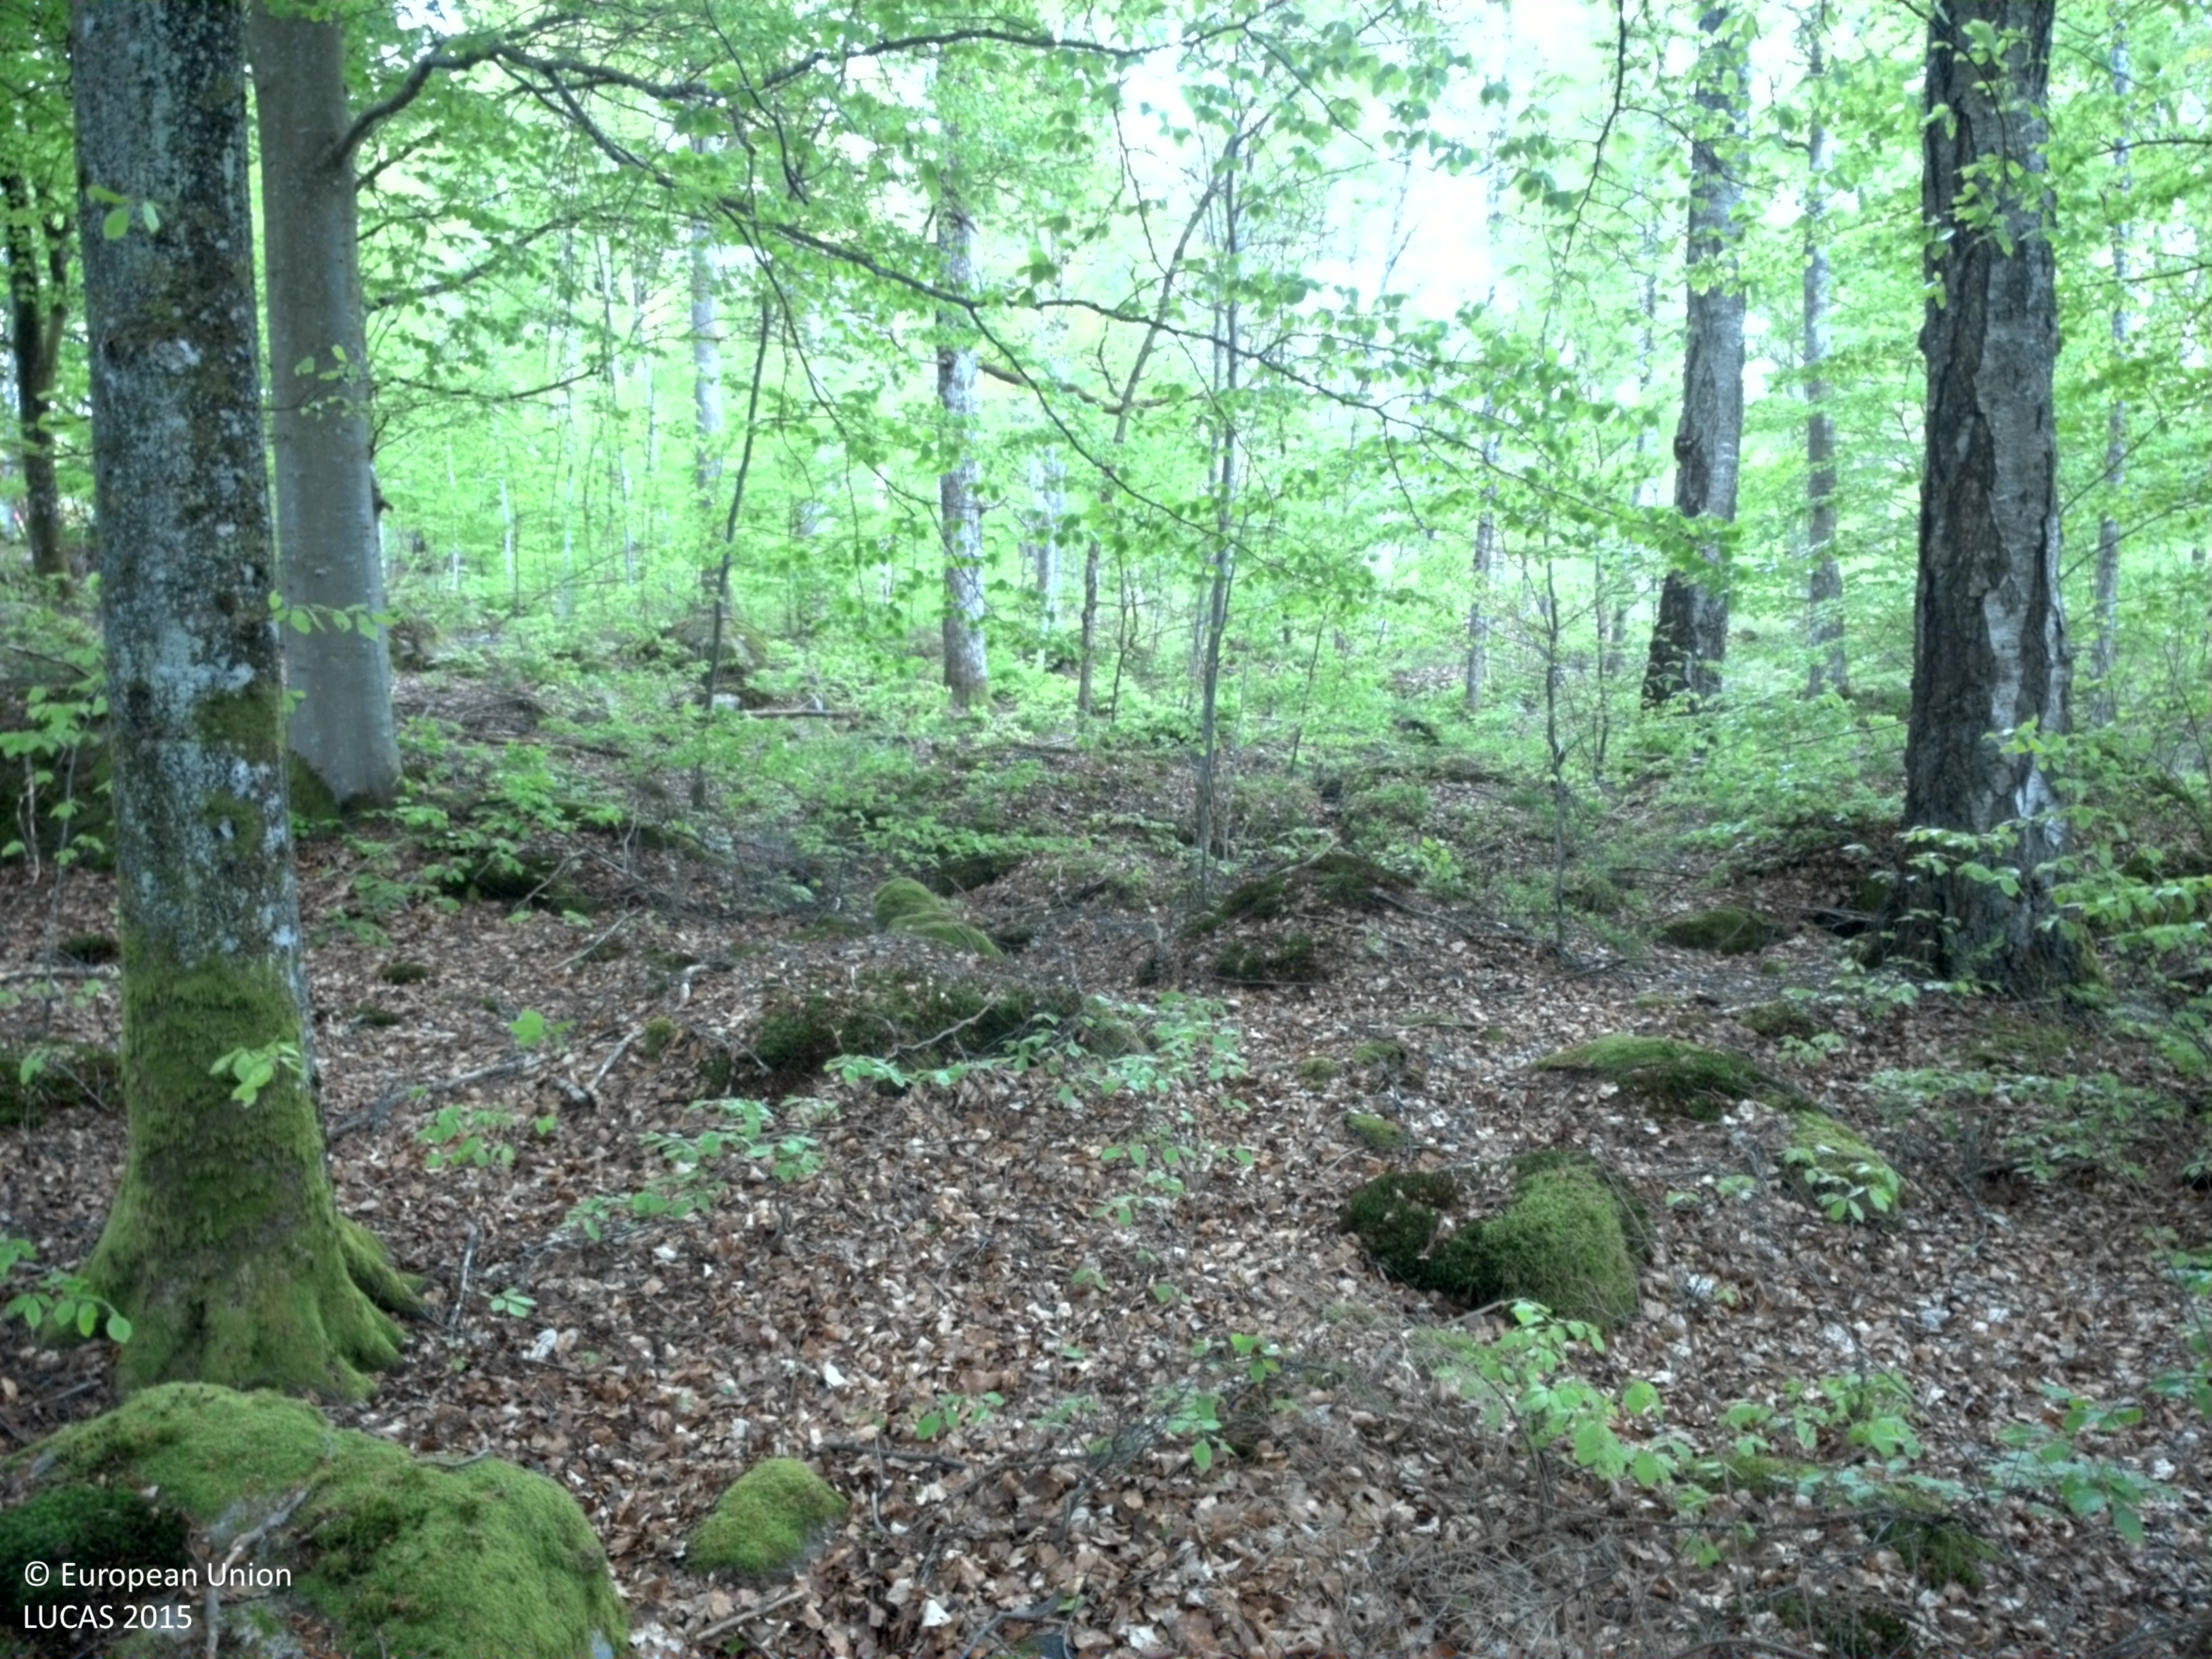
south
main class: Woodland
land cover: Broadleaved woodland
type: beech forest
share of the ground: > 75 %
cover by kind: broadleaved forest trees 80 %, herbaceous plants 10 %, lichens and mosses 10 %
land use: Amenities, museums, leisure
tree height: > 5 m
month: May
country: SE
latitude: 56.6487
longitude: 14.5149
